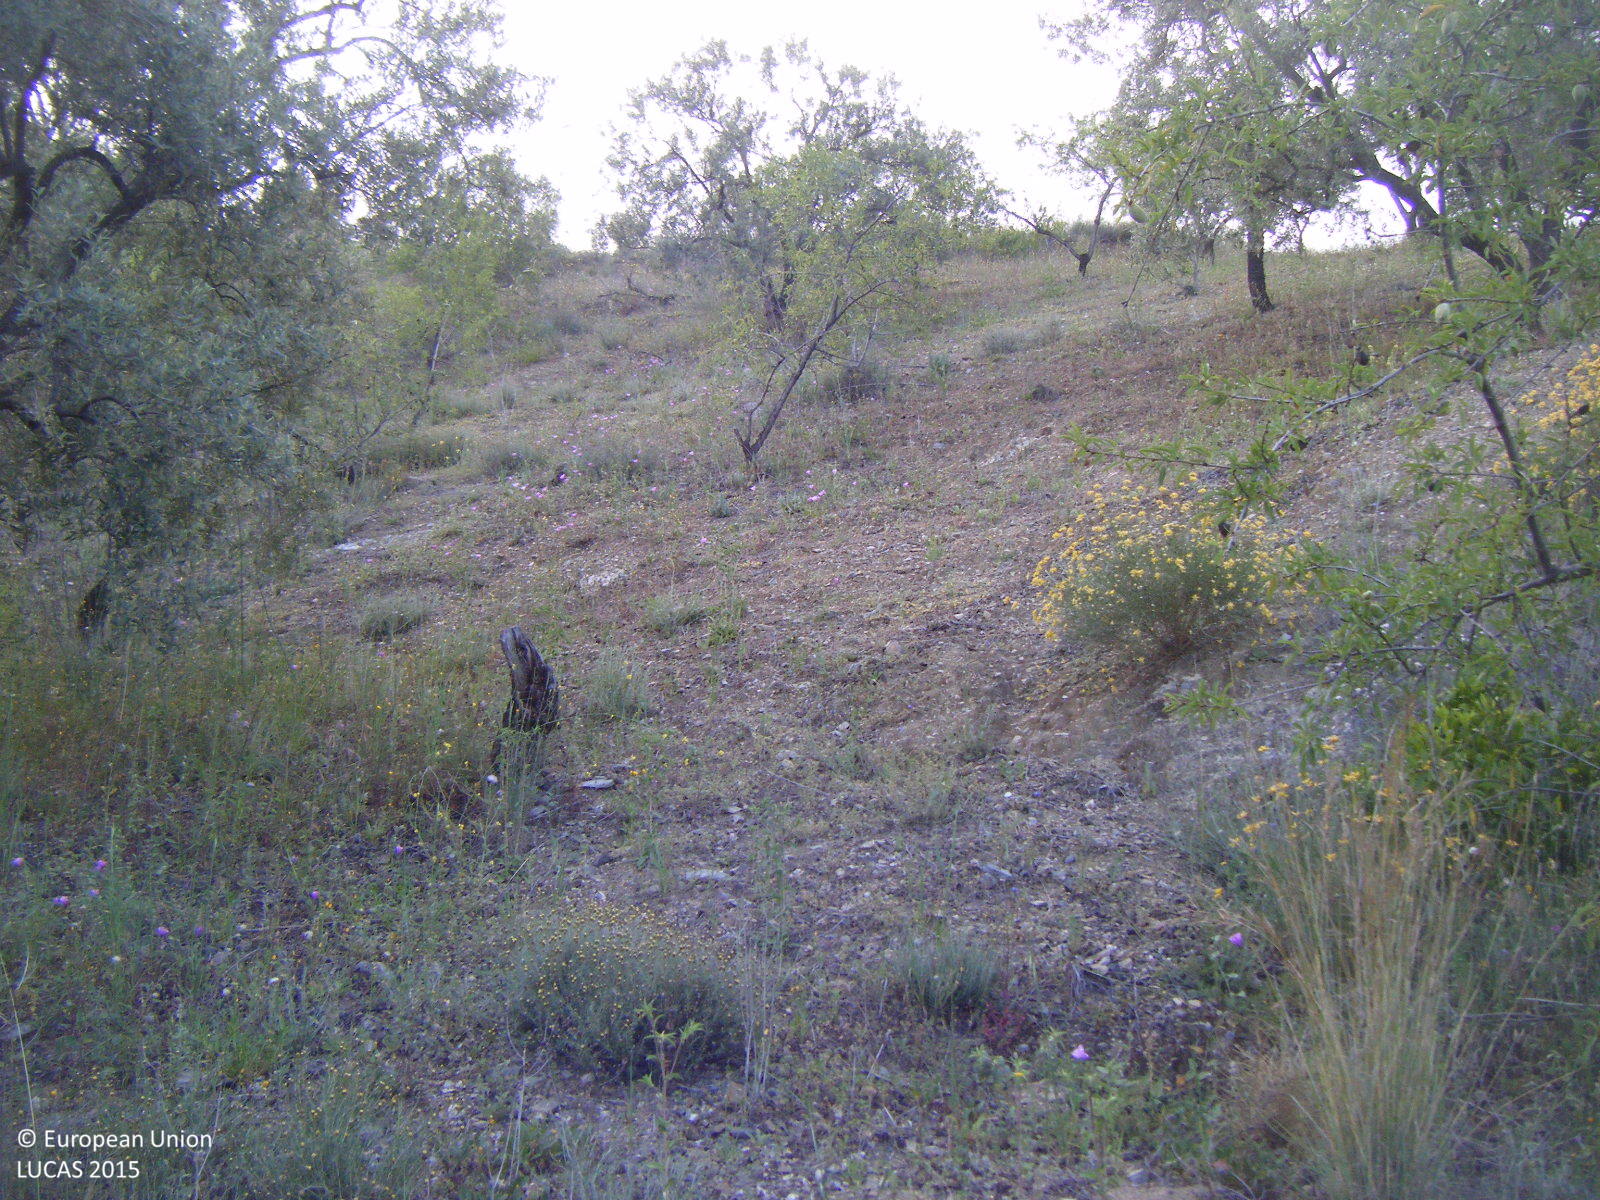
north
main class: Cropland
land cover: Olive groves
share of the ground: 25 - 50 %
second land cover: Nuts trees
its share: 10 - 25 %
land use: Agriculture (excluding fallow land and kitchen gardens)
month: April
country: ES
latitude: 36.8473
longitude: -4.0400
